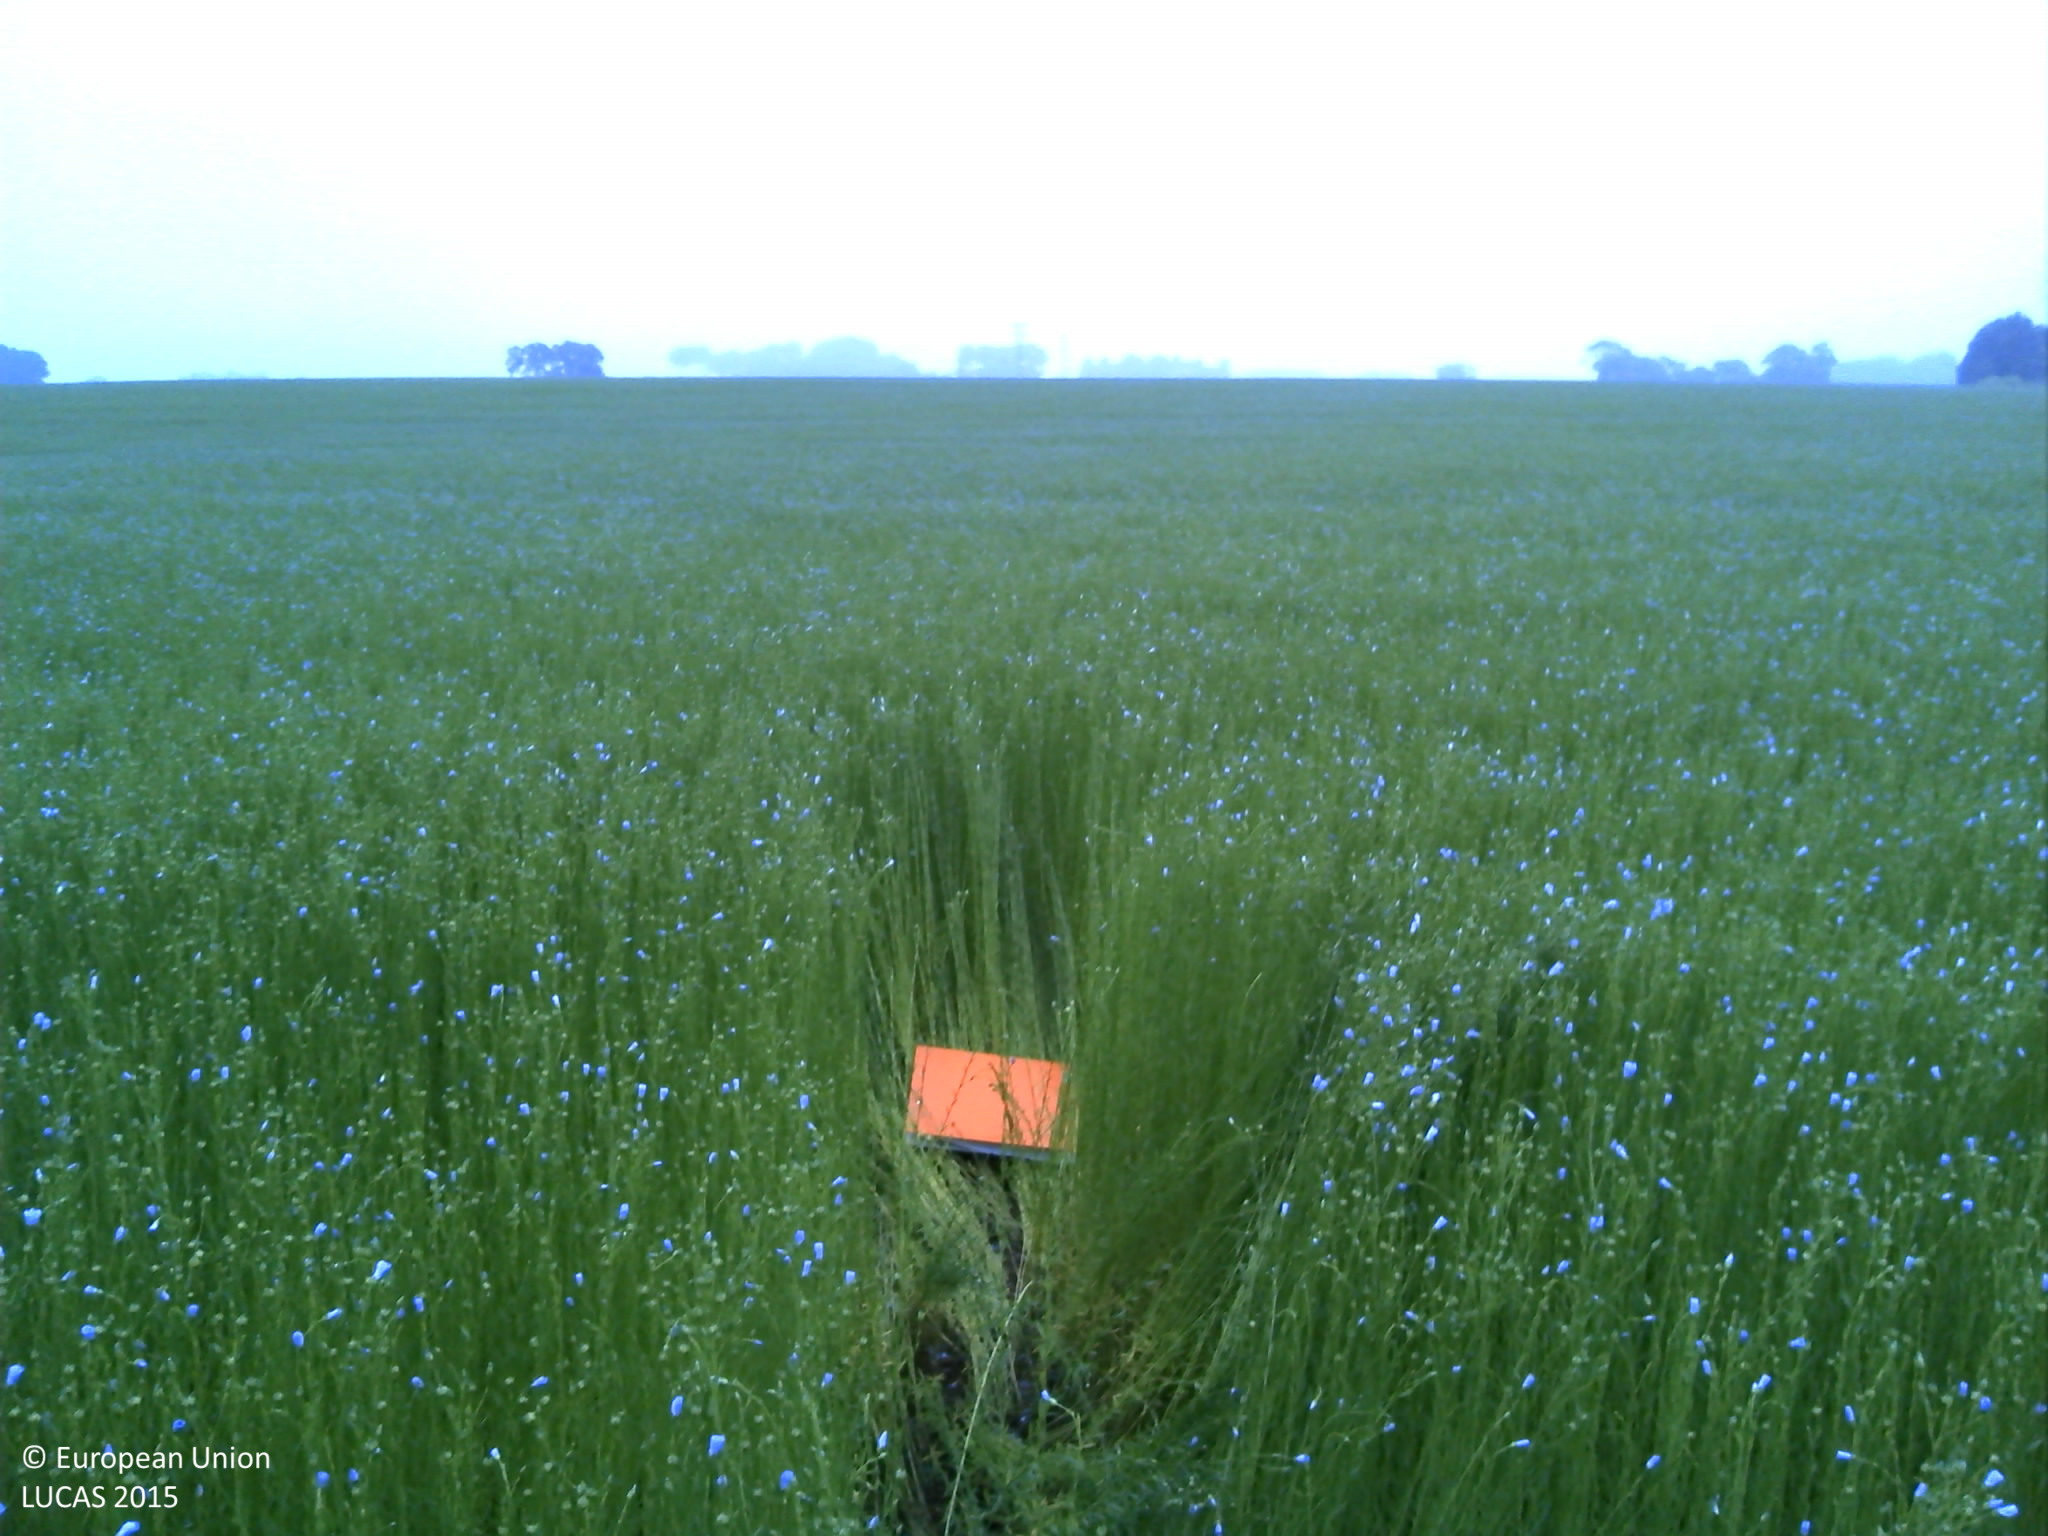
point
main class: Cropland
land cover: Other fibre and oleaginous crops
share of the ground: > 75 %
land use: Agriculture (excluding fallow land and kitchen gardens)
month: June
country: FR
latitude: 49.6244
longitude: 0.2948
